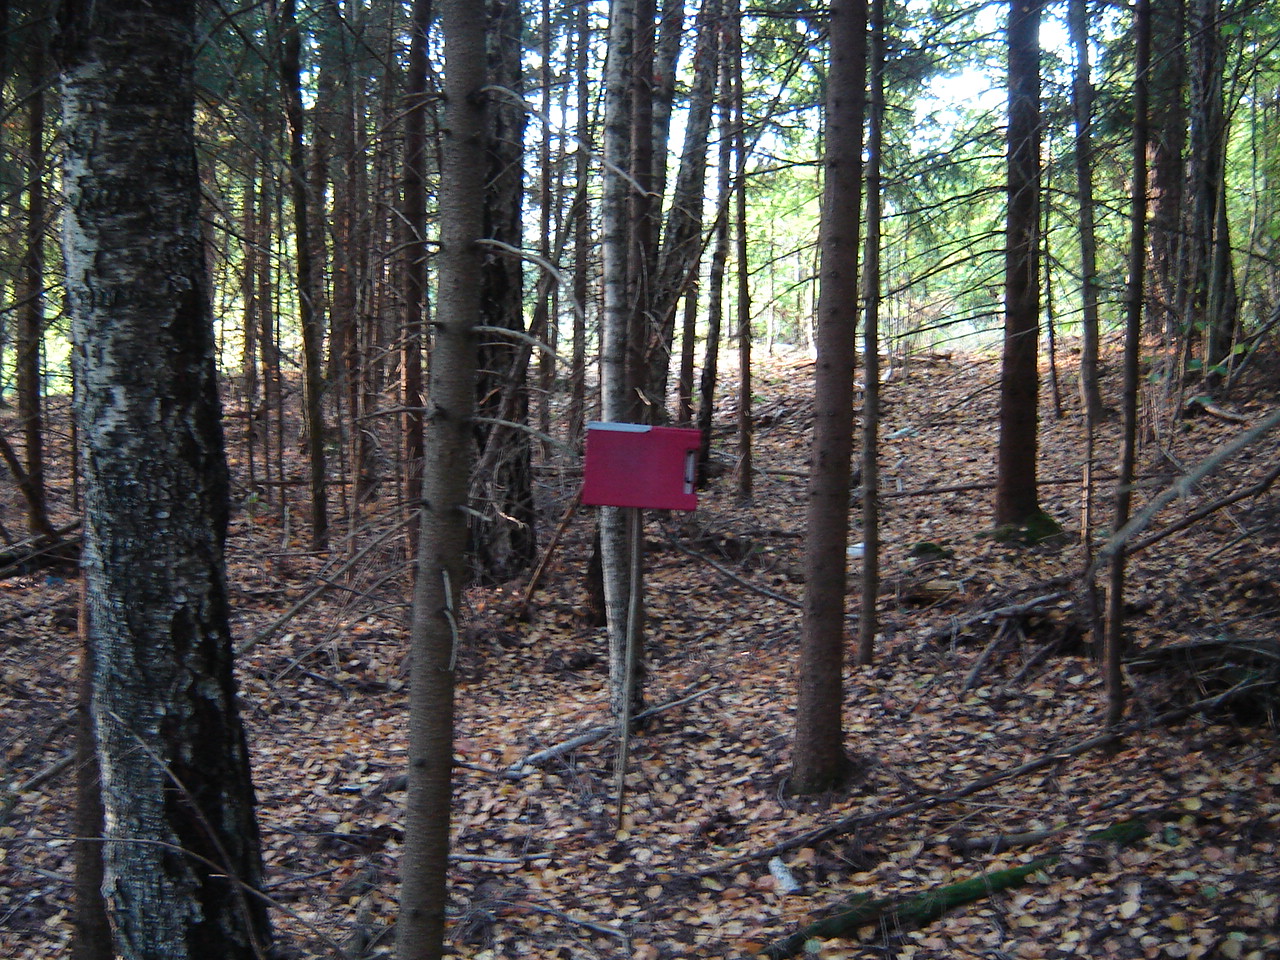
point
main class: Woodland
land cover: Pine dominated mixed woodland
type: hemiboreal forest and nemoral coniferous forest and mixed broadleaved-coniferous forest
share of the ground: > 75 %
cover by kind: coniferous forest trees 70 %, broadleaved forest trees 25 %, unconsolidated bare surface 5 %
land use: Forestry
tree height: > 5 m
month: August
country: LT
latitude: 54.7161
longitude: 24.9695
